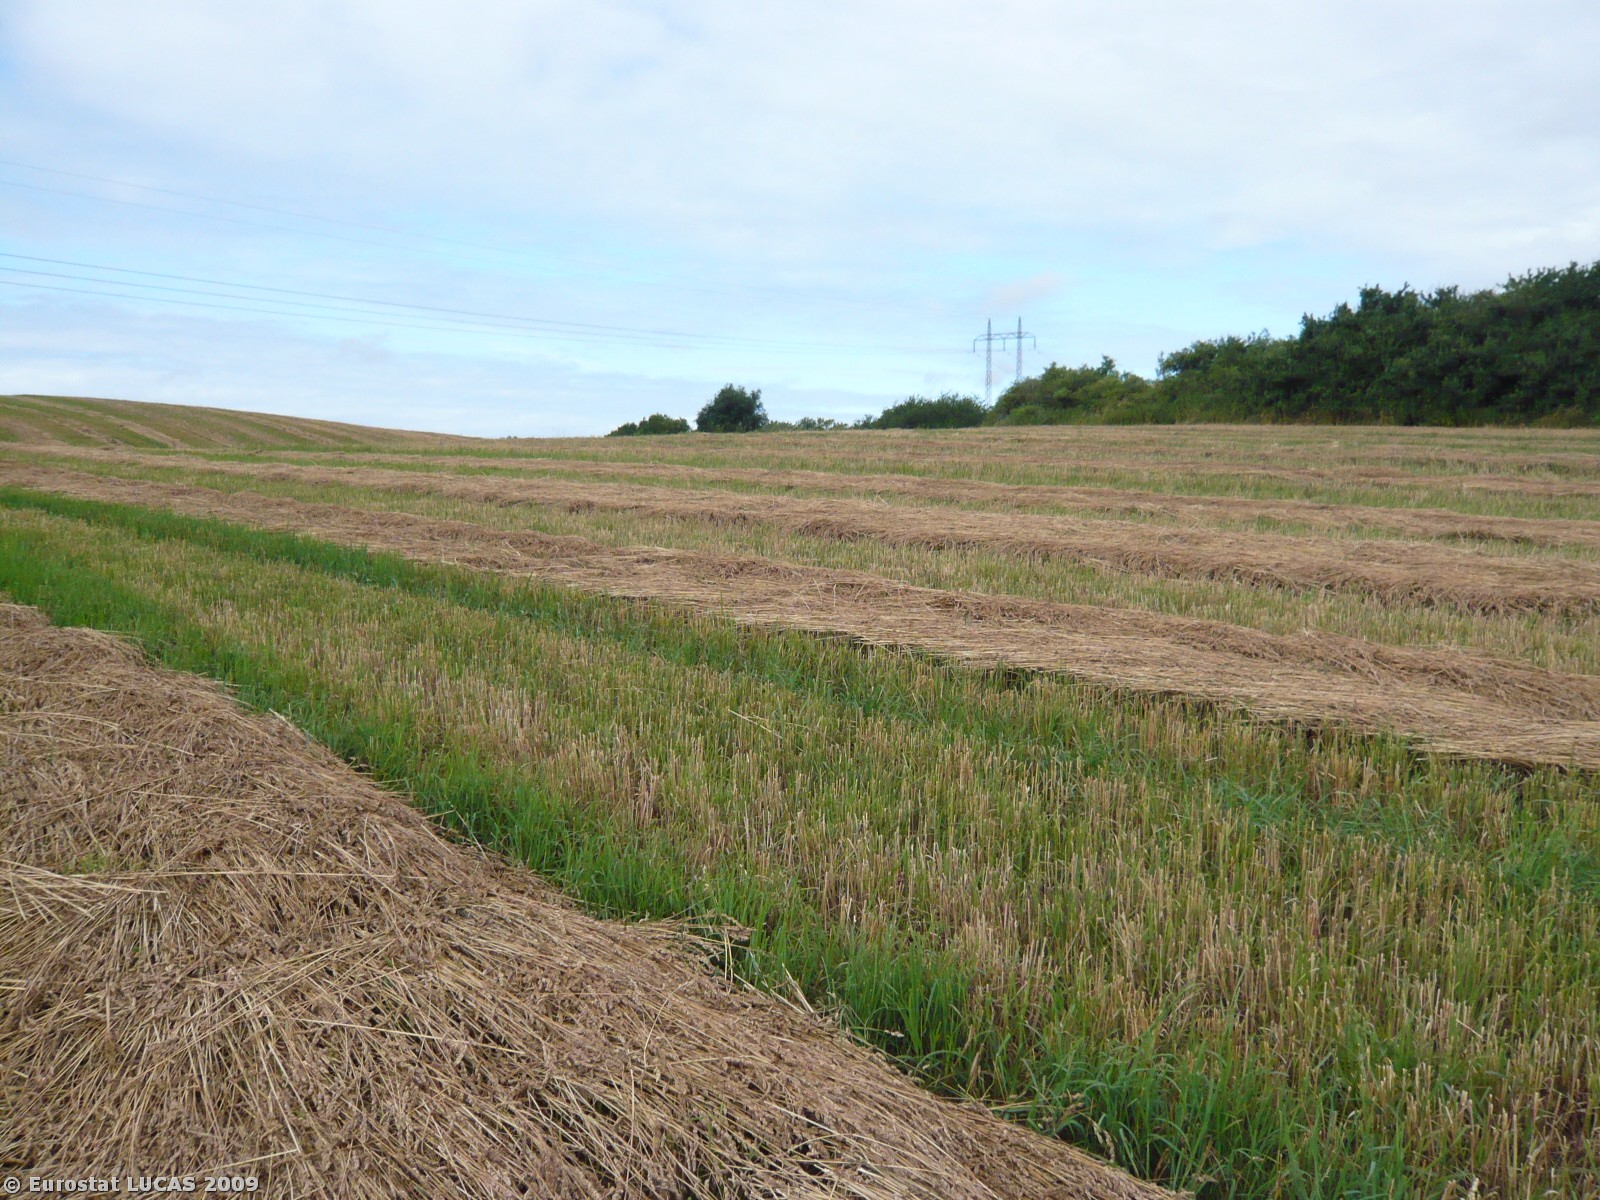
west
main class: Grassland
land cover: Grassland without tree/shrub cover
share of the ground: > 75 %
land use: Agriculture (excluding fallow land and kitchen gardens)
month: July
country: DK
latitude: 55.6240
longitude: 11.2851
